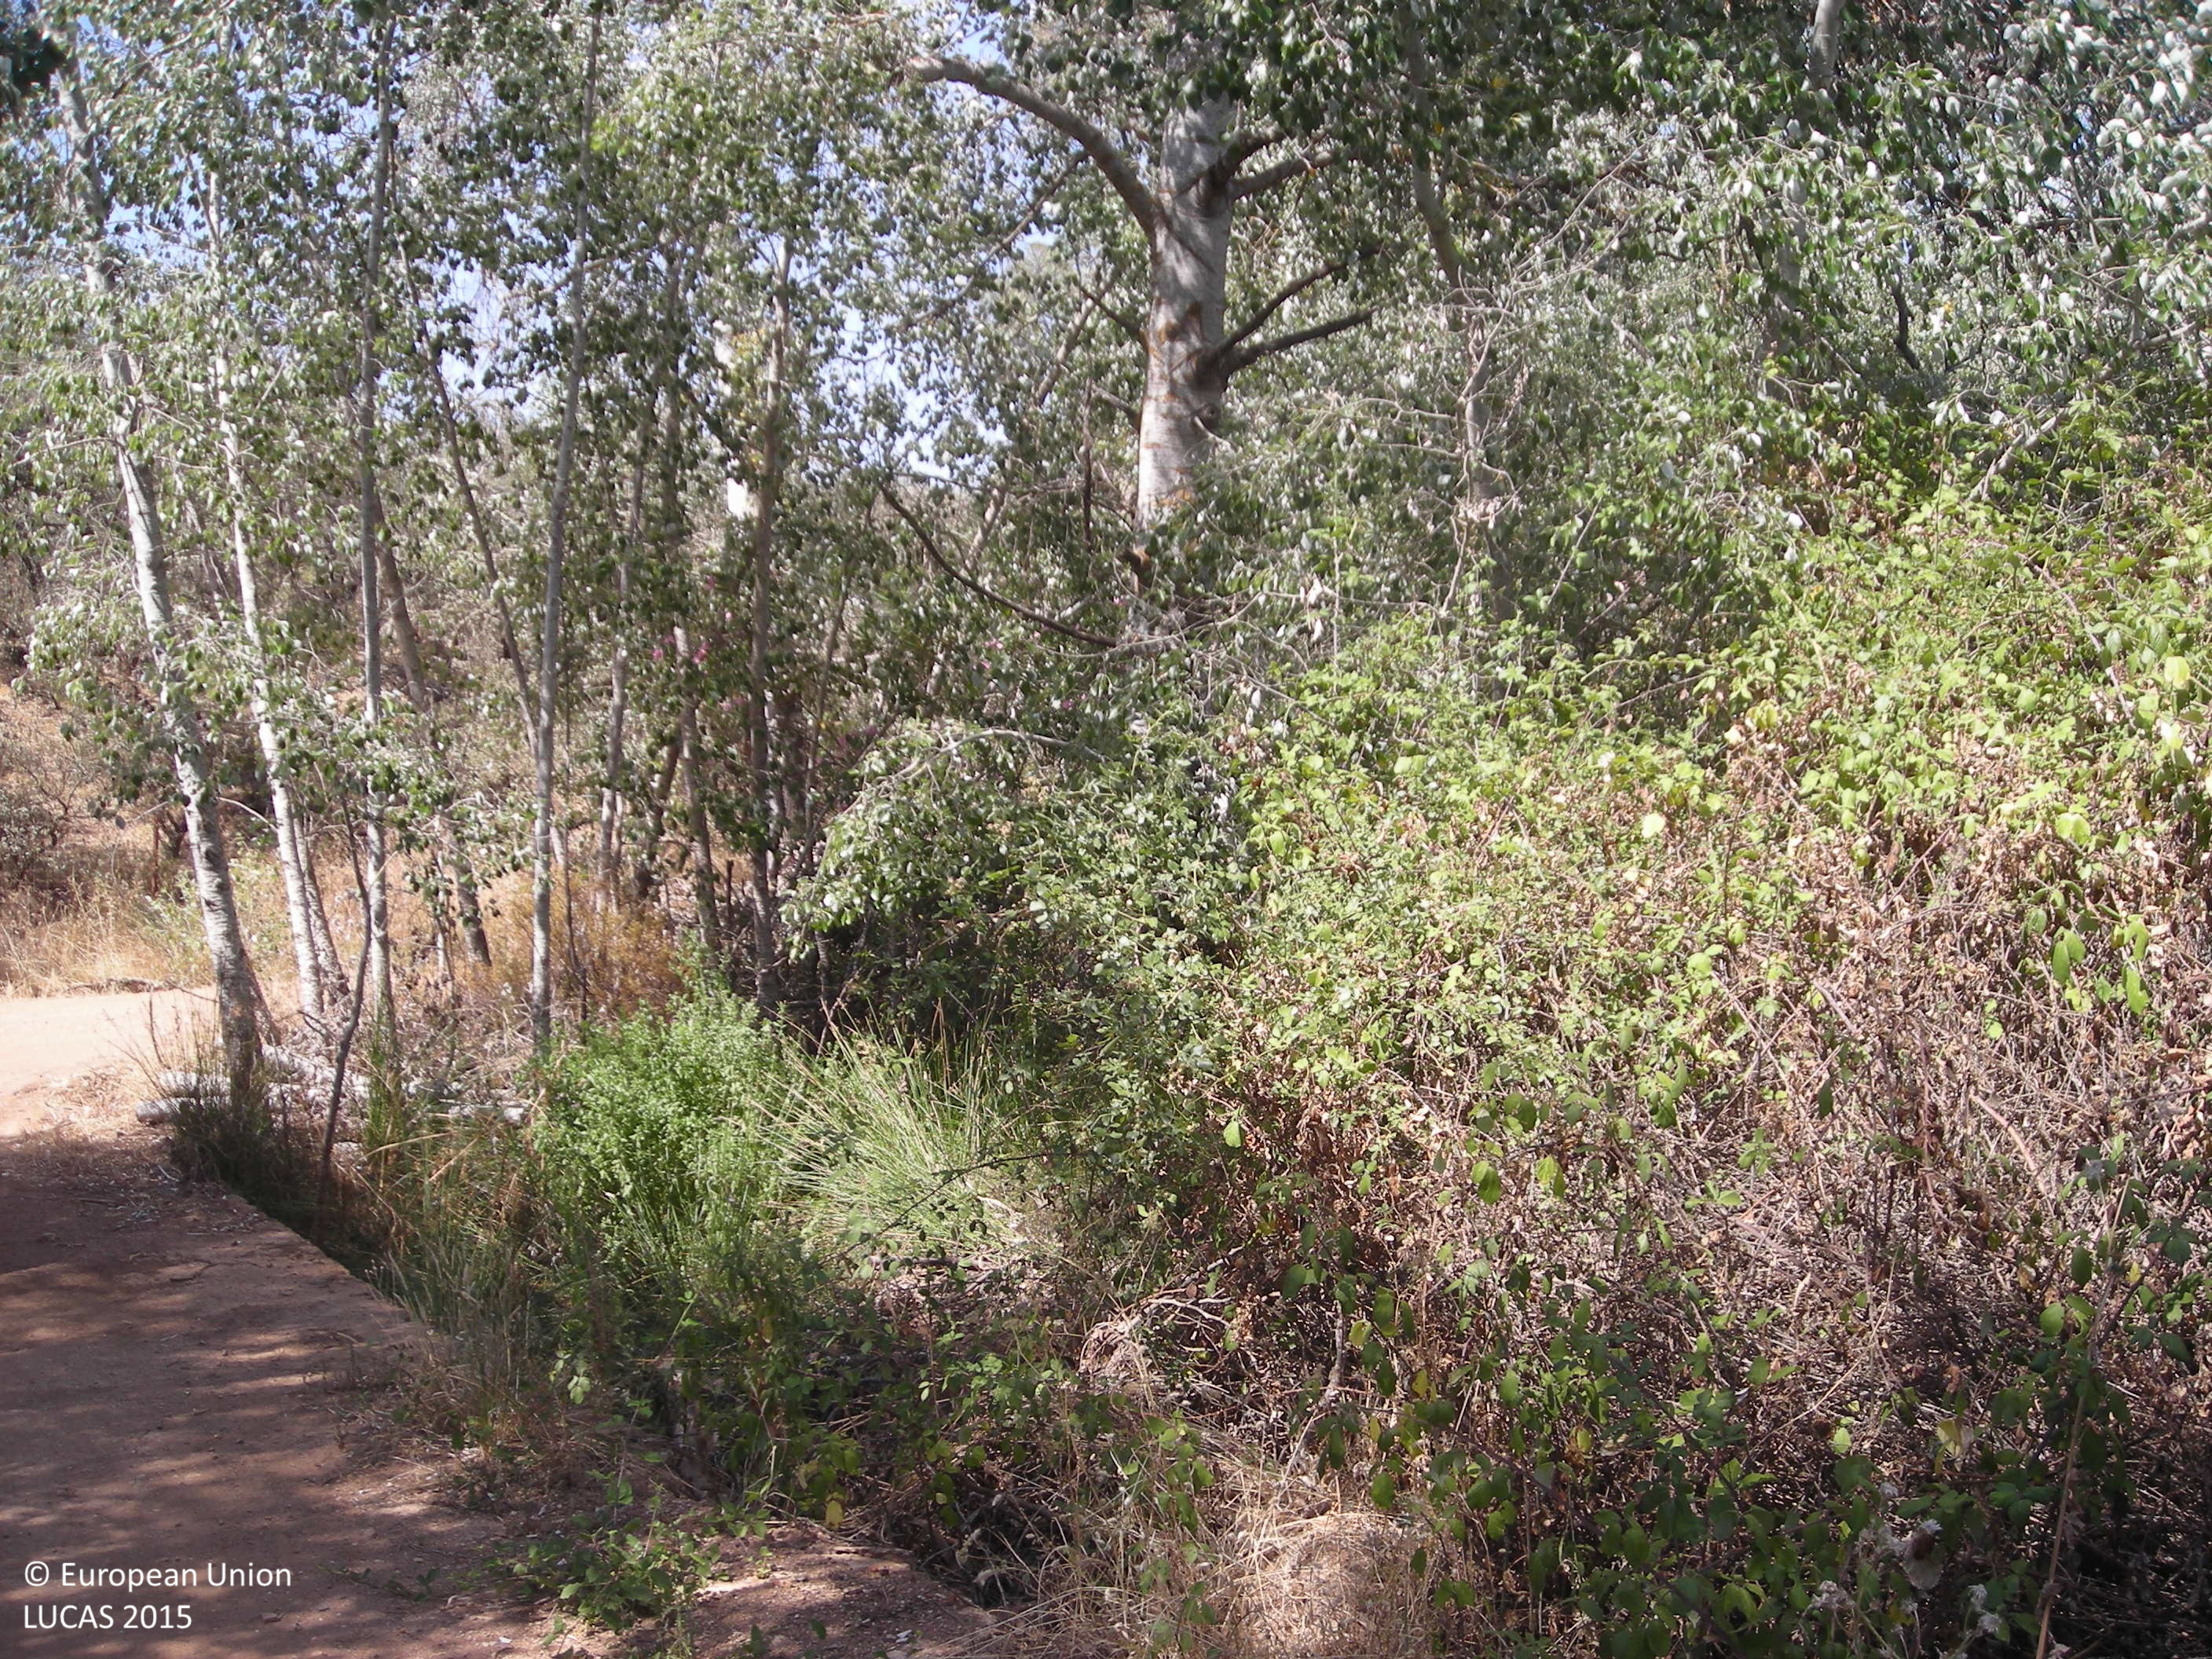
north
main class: Woodland
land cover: Broadleaved woodland
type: broadleaved evergreen forest
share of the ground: 10 - 25 %
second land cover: Grassland without tree/shrub cover
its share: > 75 %
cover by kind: herbaceous plants 90 %, broadleaved forest trees 10 %
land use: Forestry
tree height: > 5 m
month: July
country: ES
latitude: 38.6716
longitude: -5.8715
